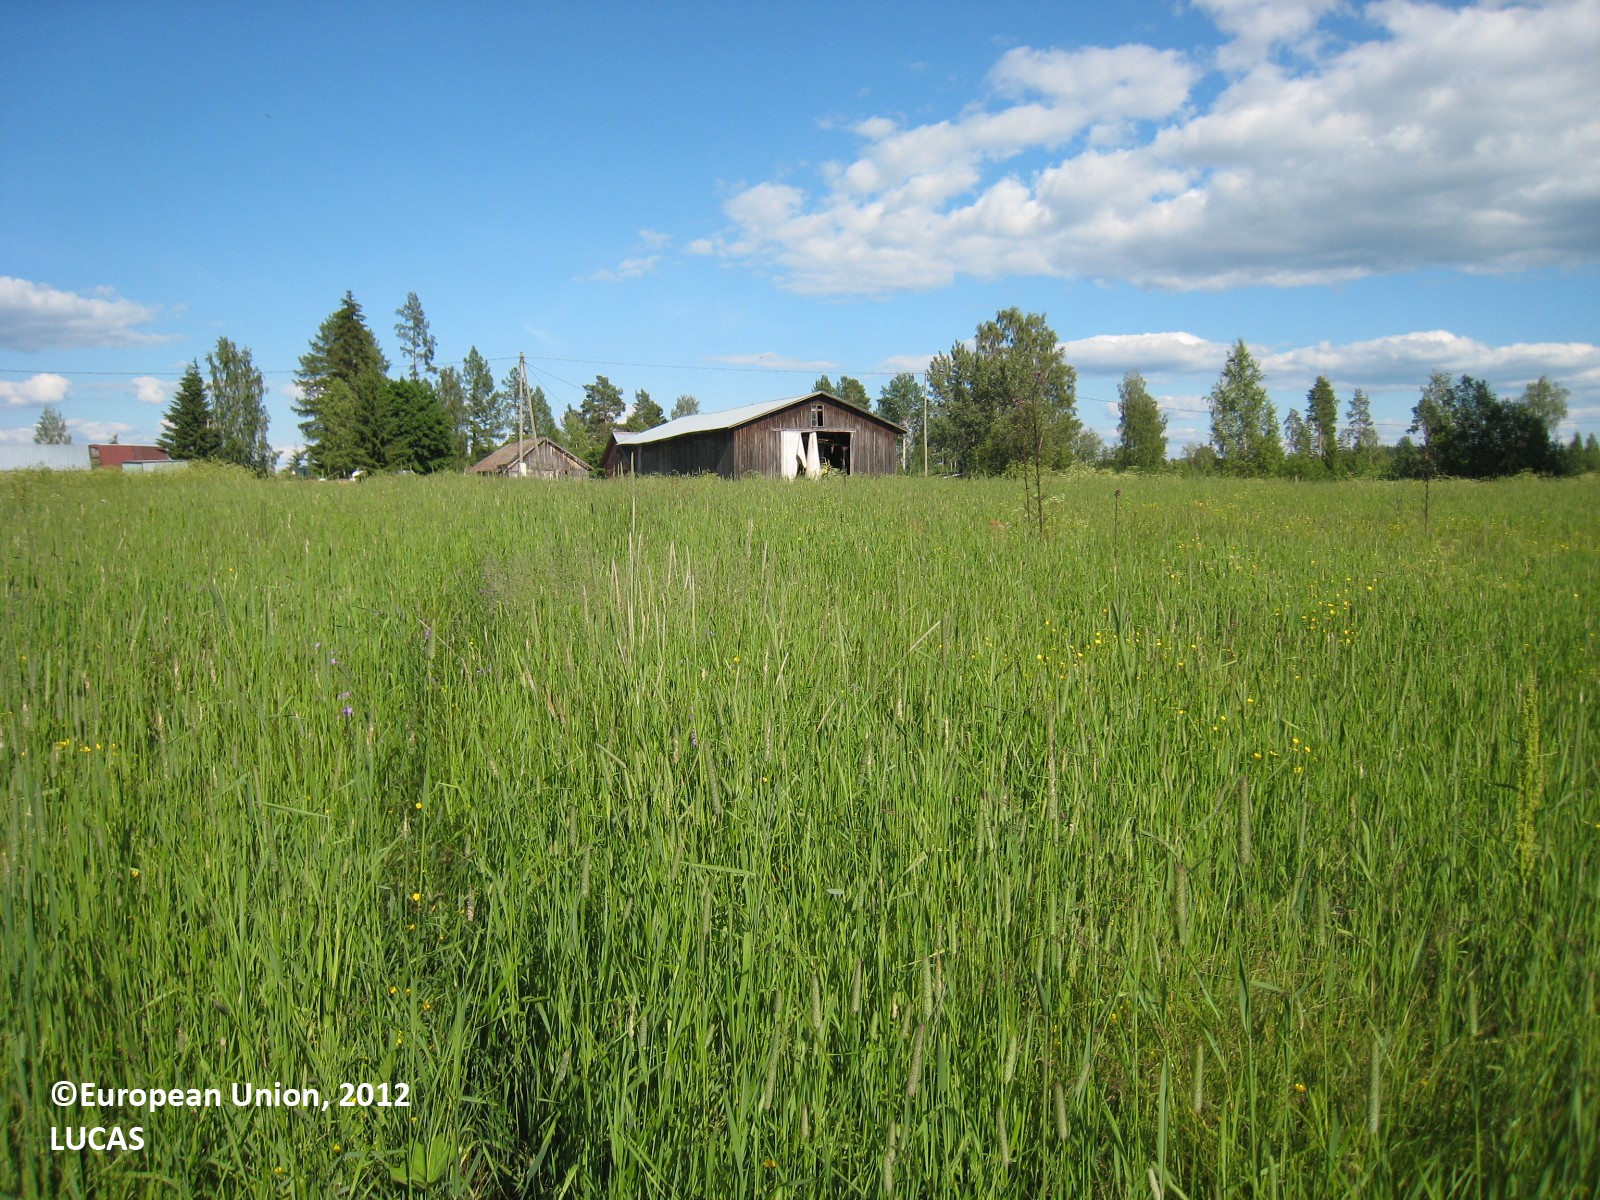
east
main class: Cropland
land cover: Temporary grasslands
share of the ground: > 75 %
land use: Agriculture (excluding fallow land and kitchen gardens)
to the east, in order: Temporary grasslands; Spontaneously vegetated surfaces; Artificial constructions in urban areas; Temporary grasslands; Paved roads, cycling and walking lanes; Dry stone walls; Spruce dominated mixed woodland; Ditches and canals; Broadleaved woodland
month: July
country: FI
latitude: 62.6385
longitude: 26.1383
